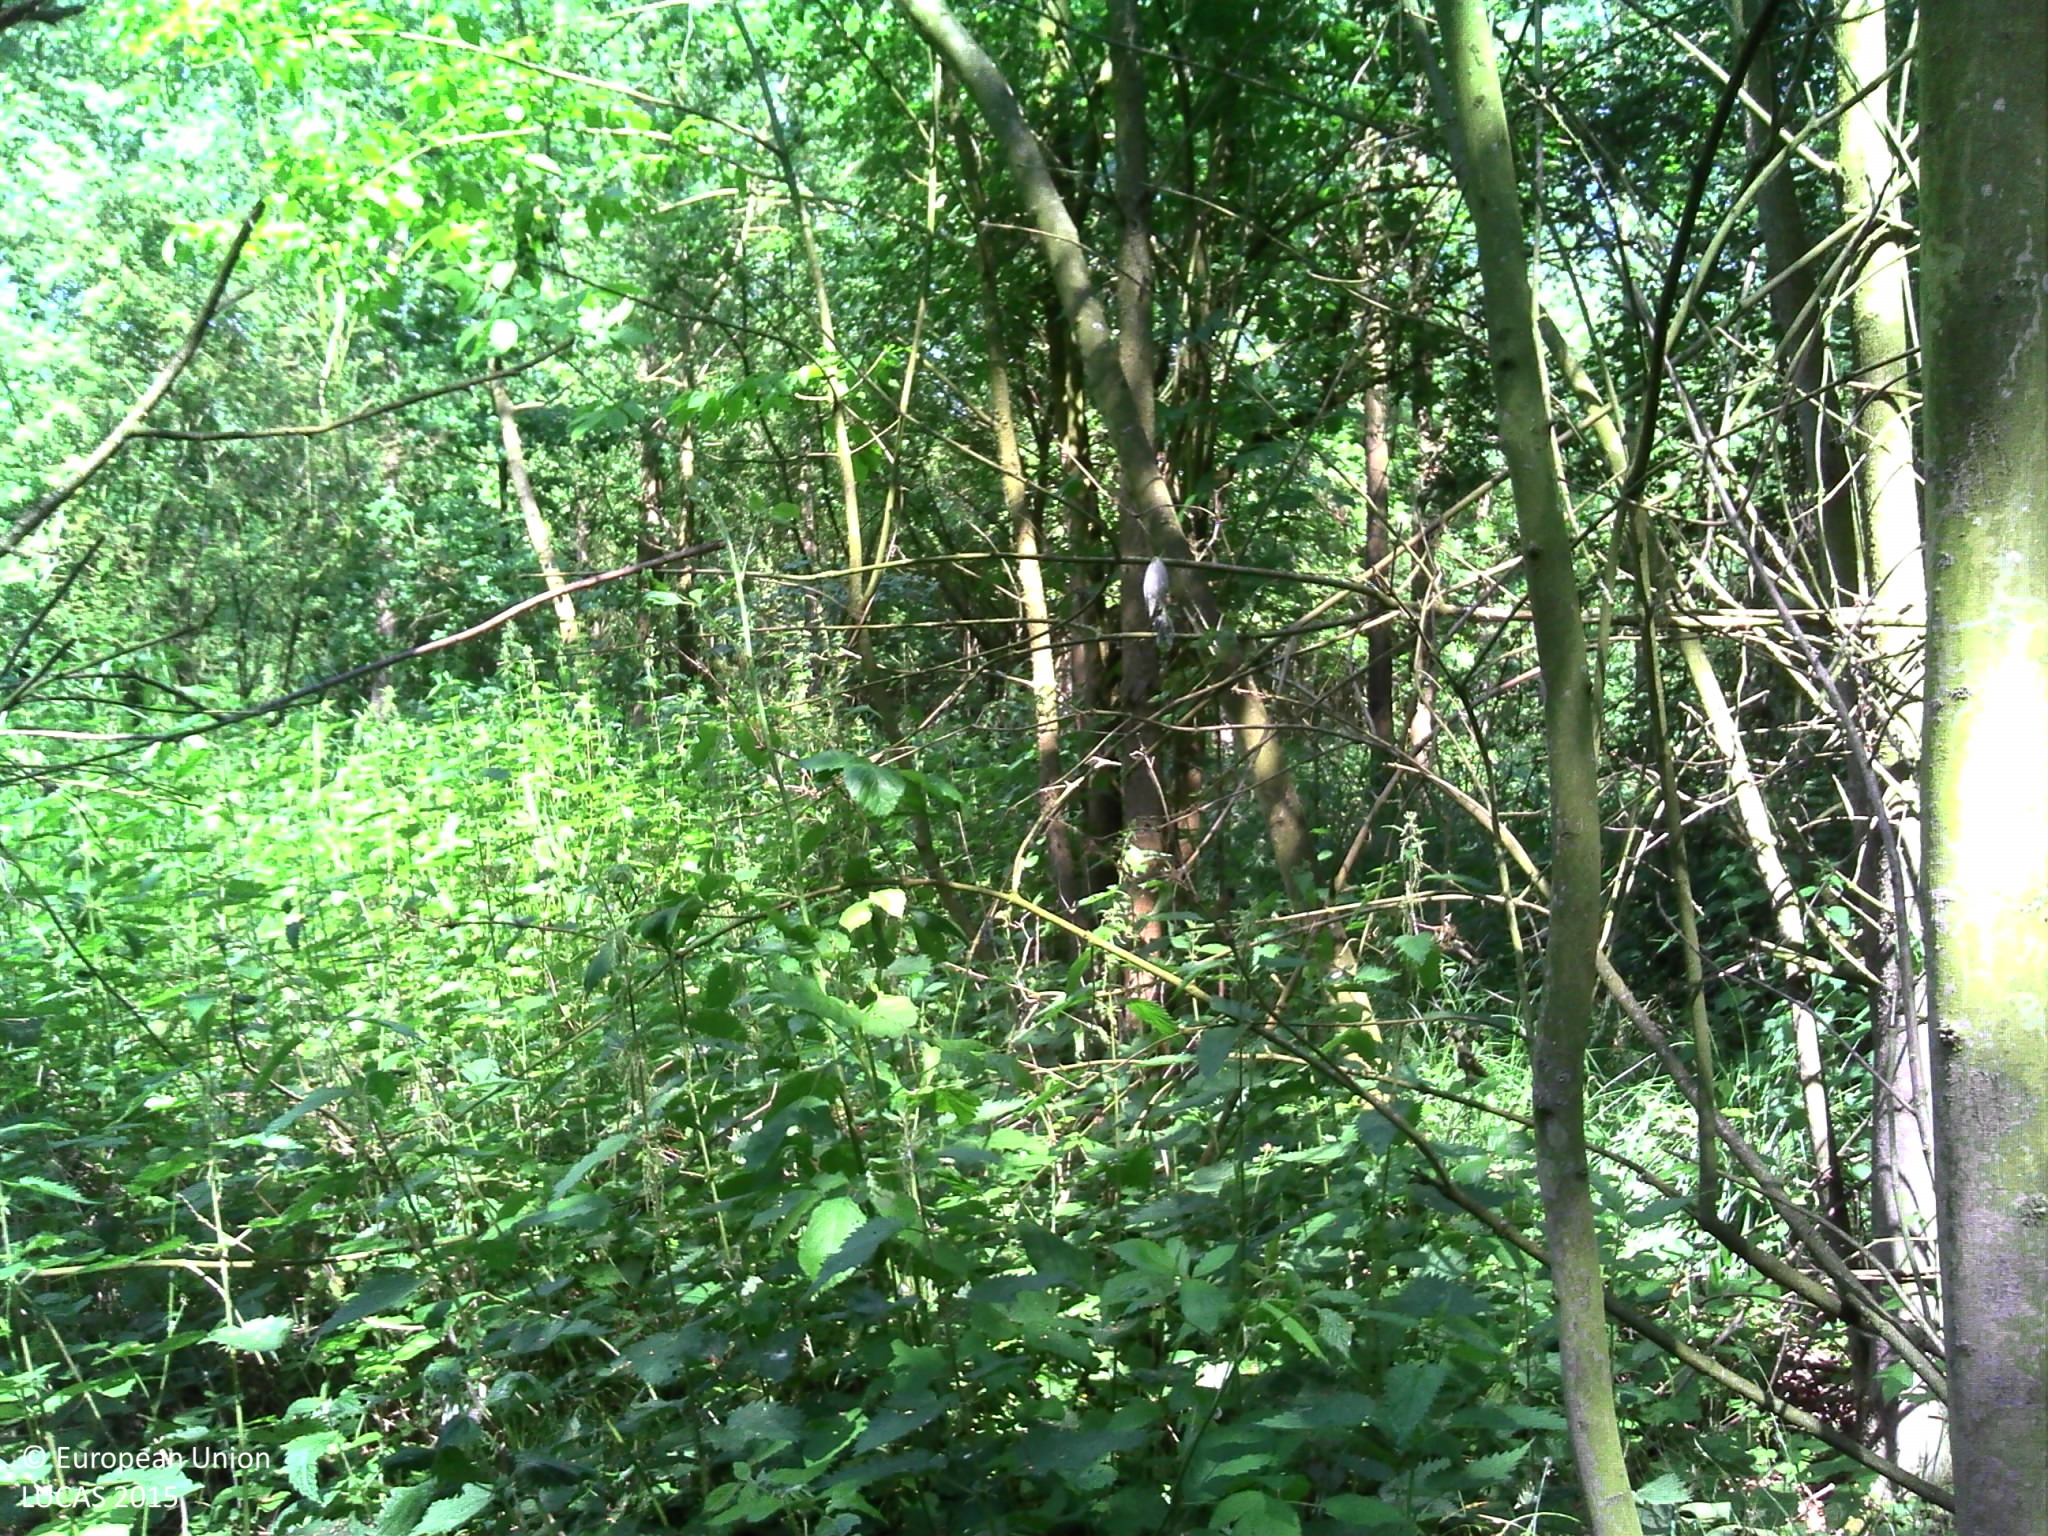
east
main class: Woodland
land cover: Broadleaved woodland
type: acidophilous oak and oak-birch forest
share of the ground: > 75 %
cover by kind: broadleaved forest trees 100 %
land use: Forestry
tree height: > 5 m
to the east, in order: Broadleaved woodland; Inland fresh running water; Broadleaved woodland; Grass margins; Tracks; Grass margins; Broadleaved woodland; Tracks; Broadleaved woodland; Tracks; Broadleaved woodland; Inland marshes; Broadleaved woodland
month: June
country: BE
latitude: 51.0340
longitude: 3.9619
